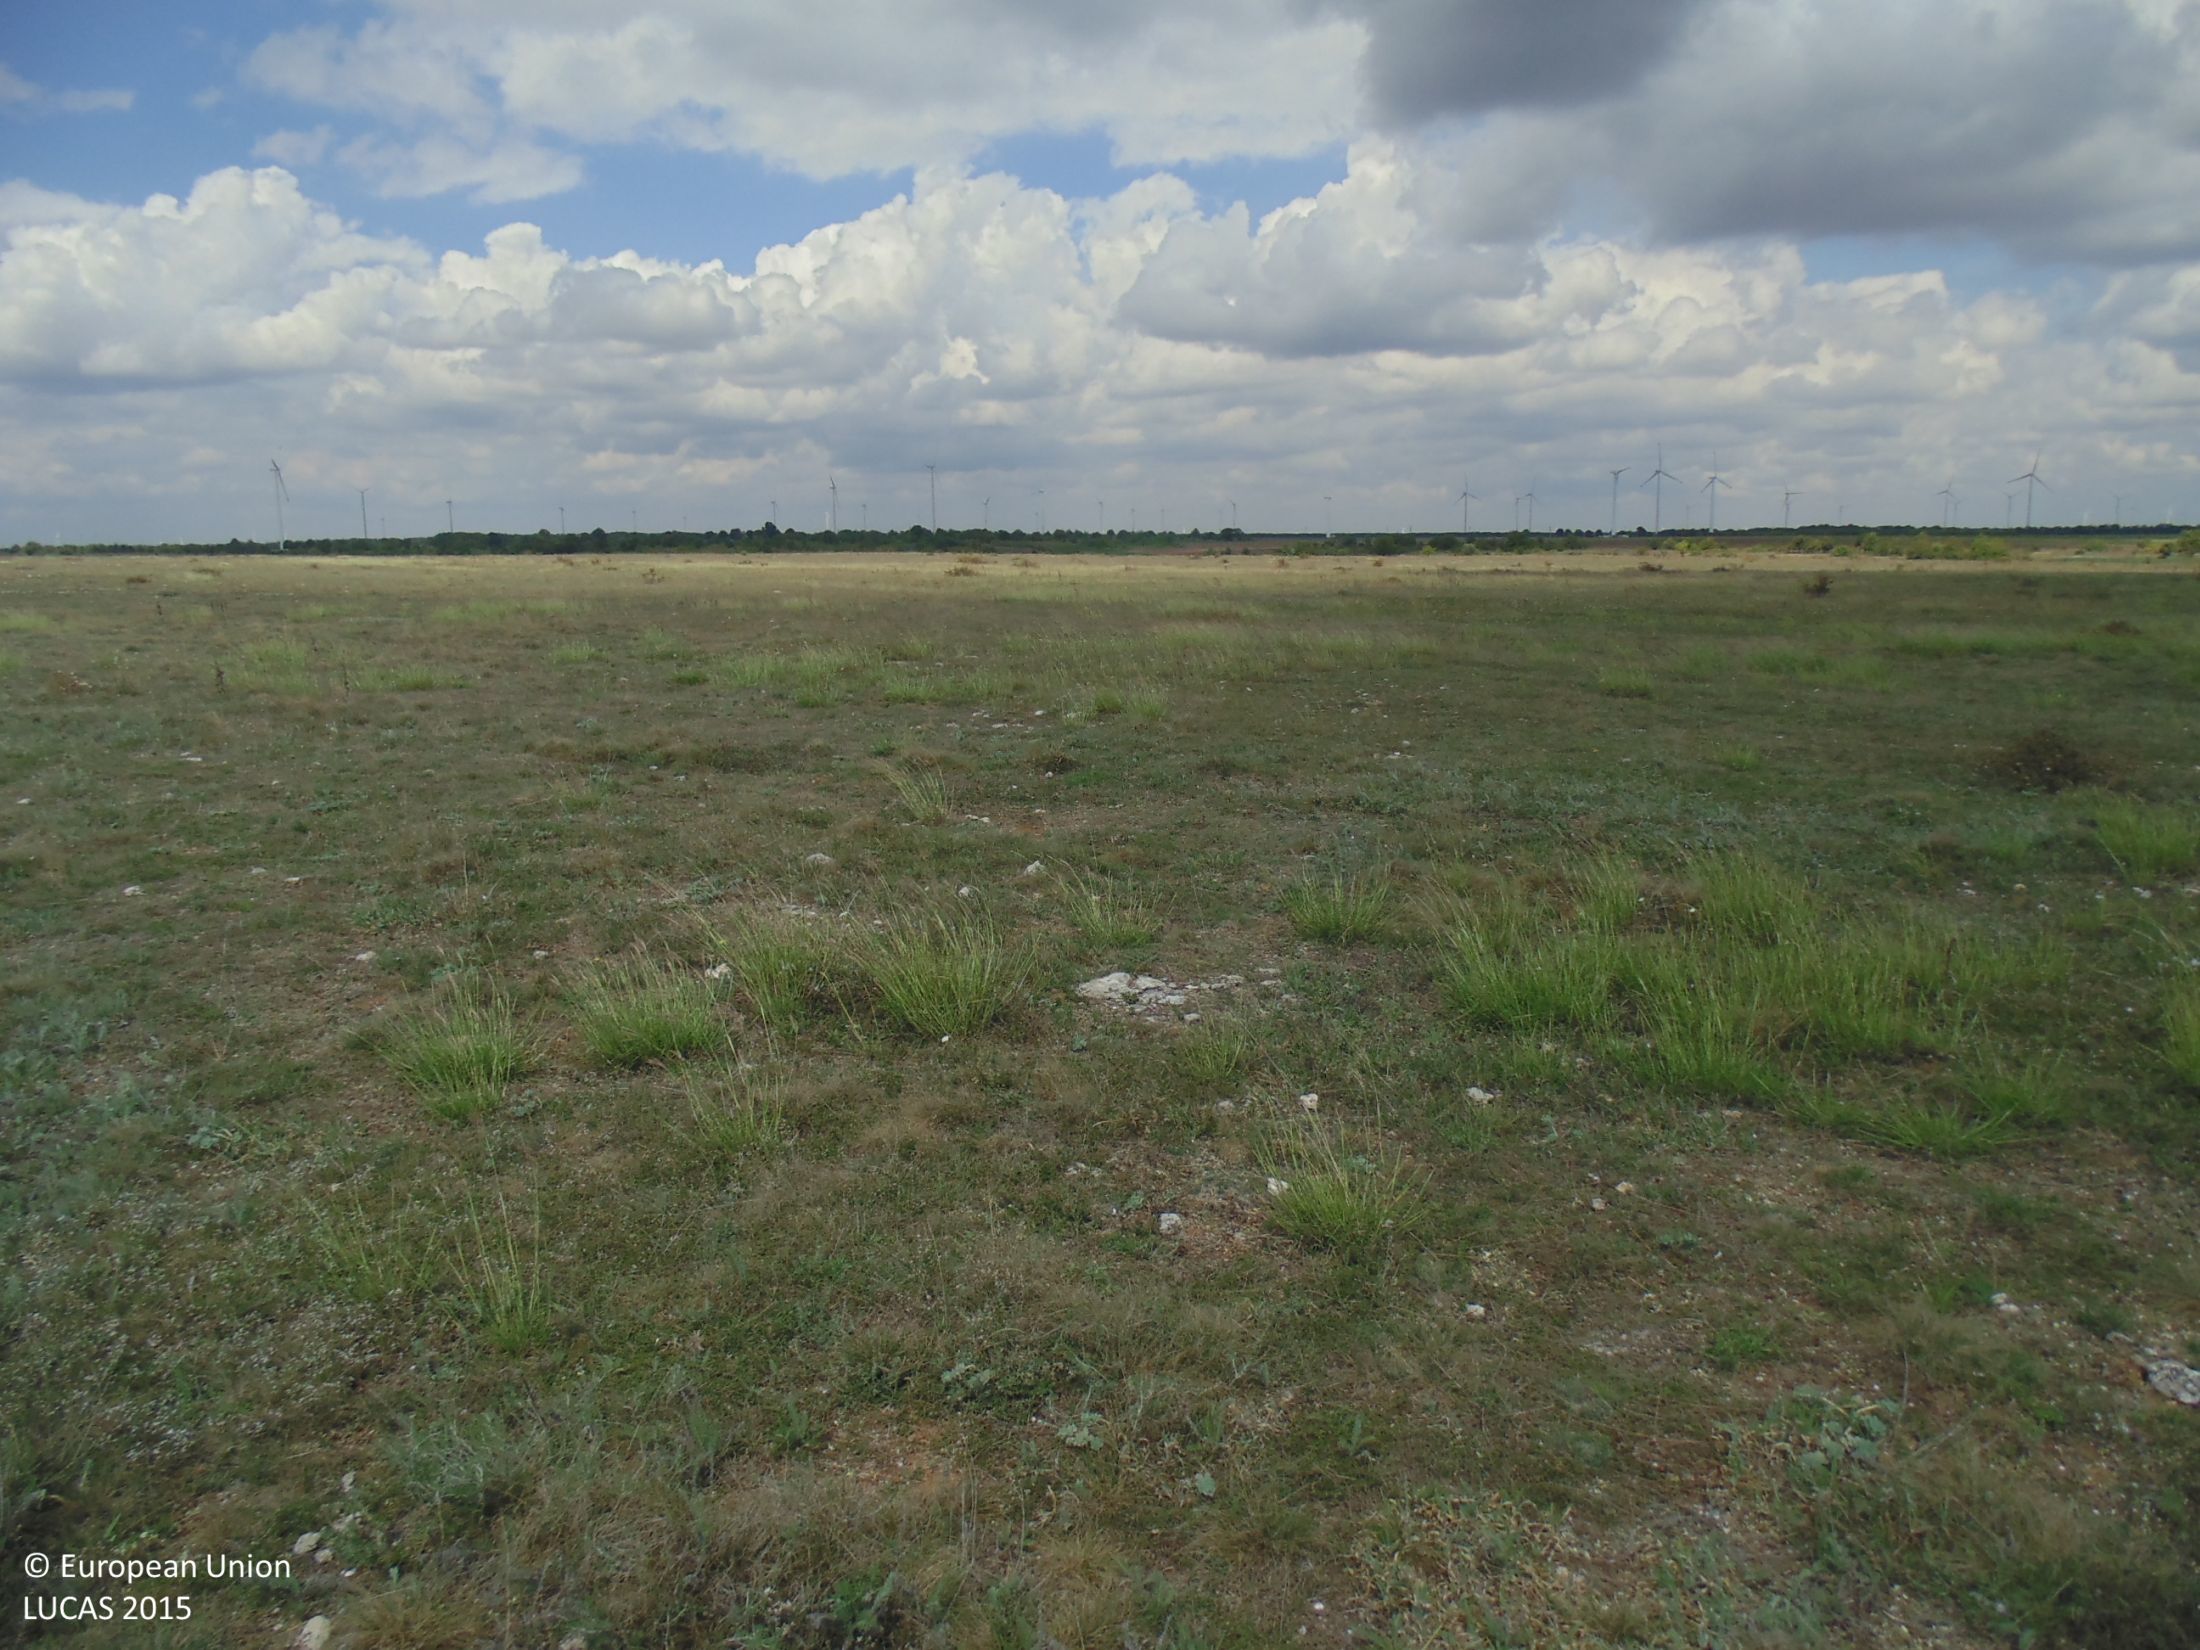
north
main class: Grassland
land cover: Grassland without tree/shrub cover
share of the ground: > 75 %
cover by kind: herbaceous plants 95 %, unconsolidated bare surface 5 %
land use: Semi-natural and natural areas not in use
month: September
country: BG
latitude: 43.3997
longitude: 28.4439
